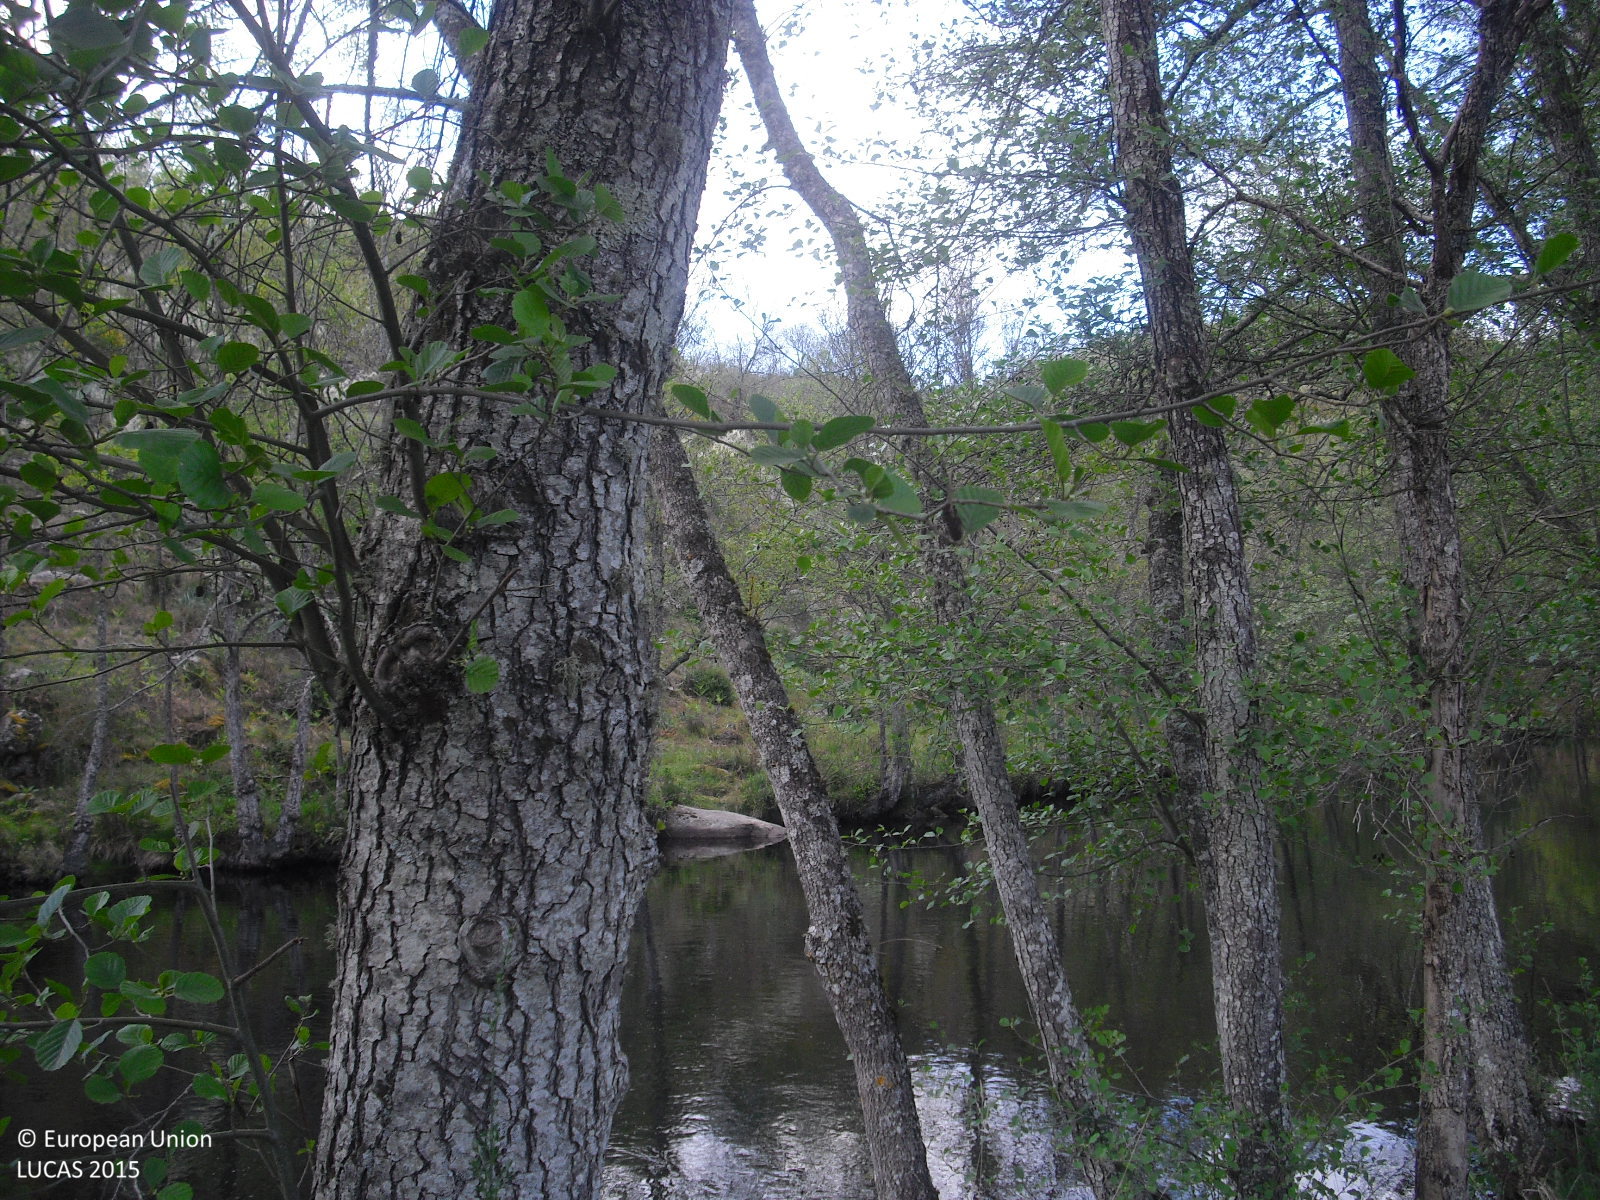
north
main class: Woodland
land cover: Broadleaved woodland
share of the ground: 25 - 50 %
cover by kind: broadleaved forest trees 30 %, herbaceous plants 30 %, shrubs 20 %, consolidated bare surface 20 %
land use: Amenities, museums, leisure
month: April
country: ES
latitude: 41.8865
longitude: -7.5240
